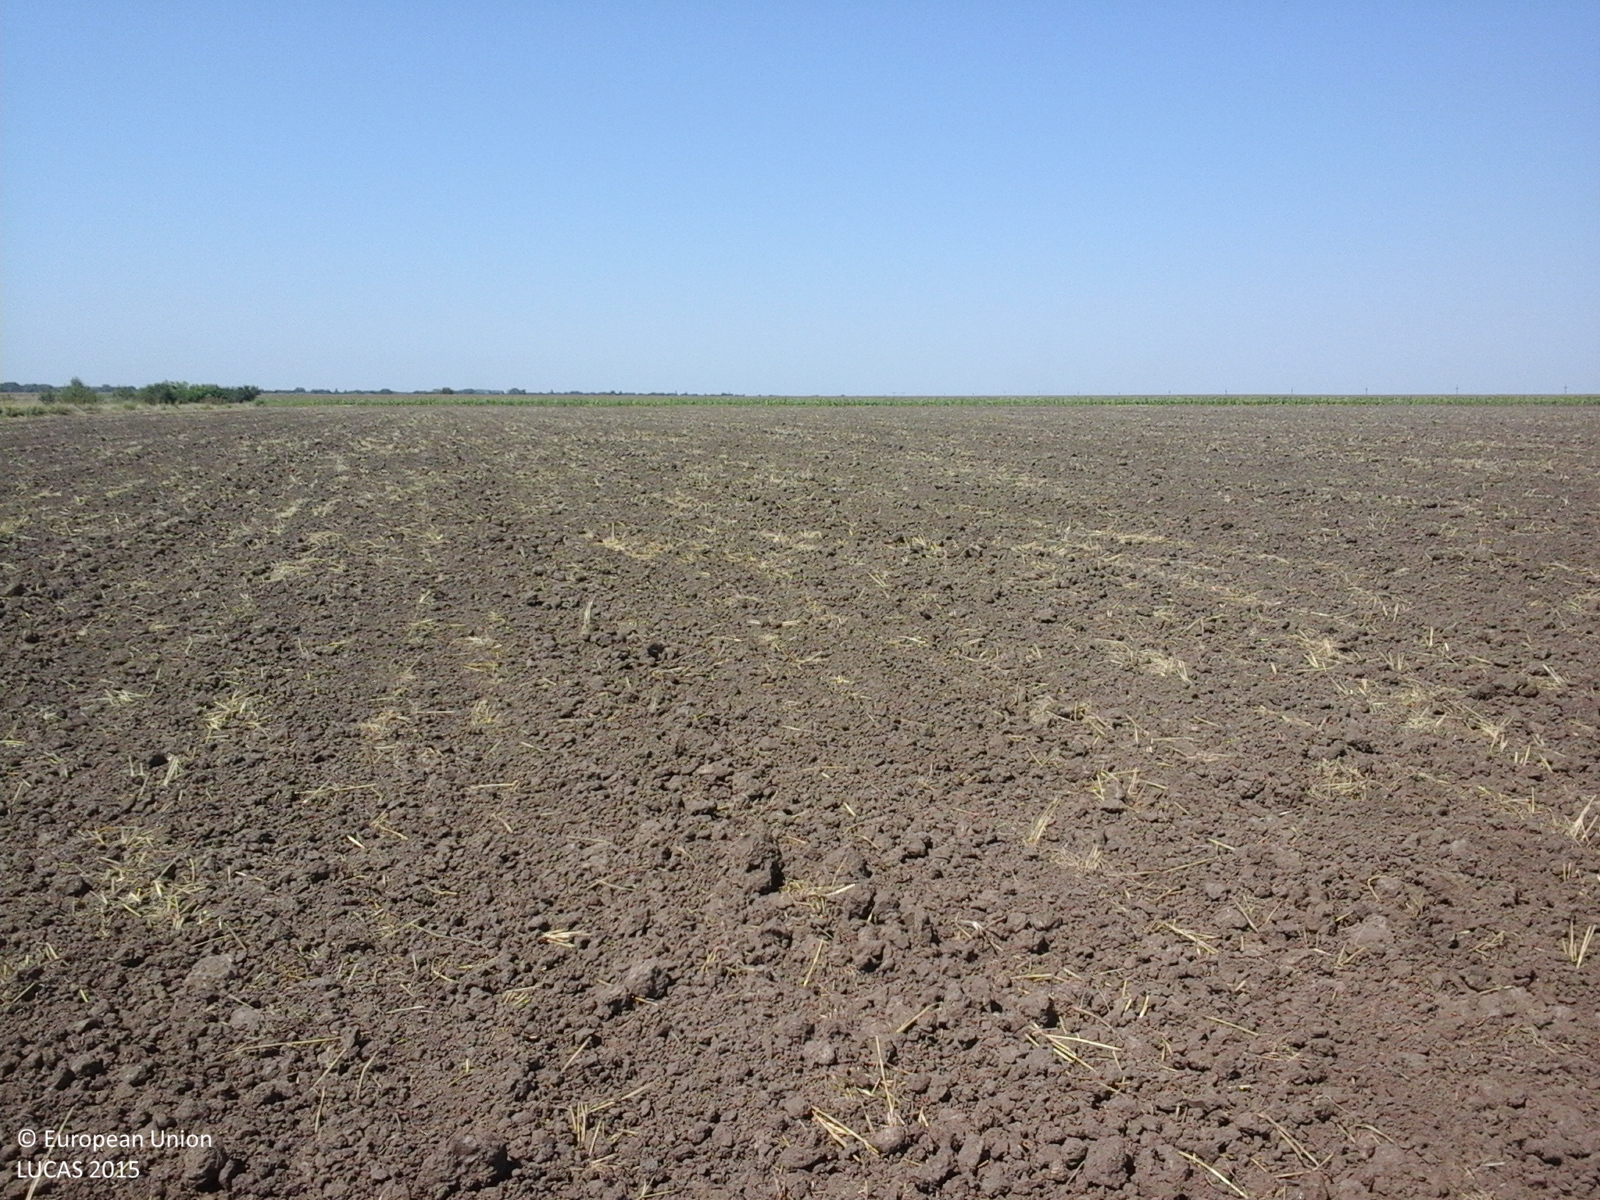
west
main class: Cropland
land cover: Common wheat
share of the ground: < 10 %
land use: Agriculture (excluding fallow land and kitchen gardens)
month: July
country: RO
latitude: 44.3367
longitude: 26.5323
